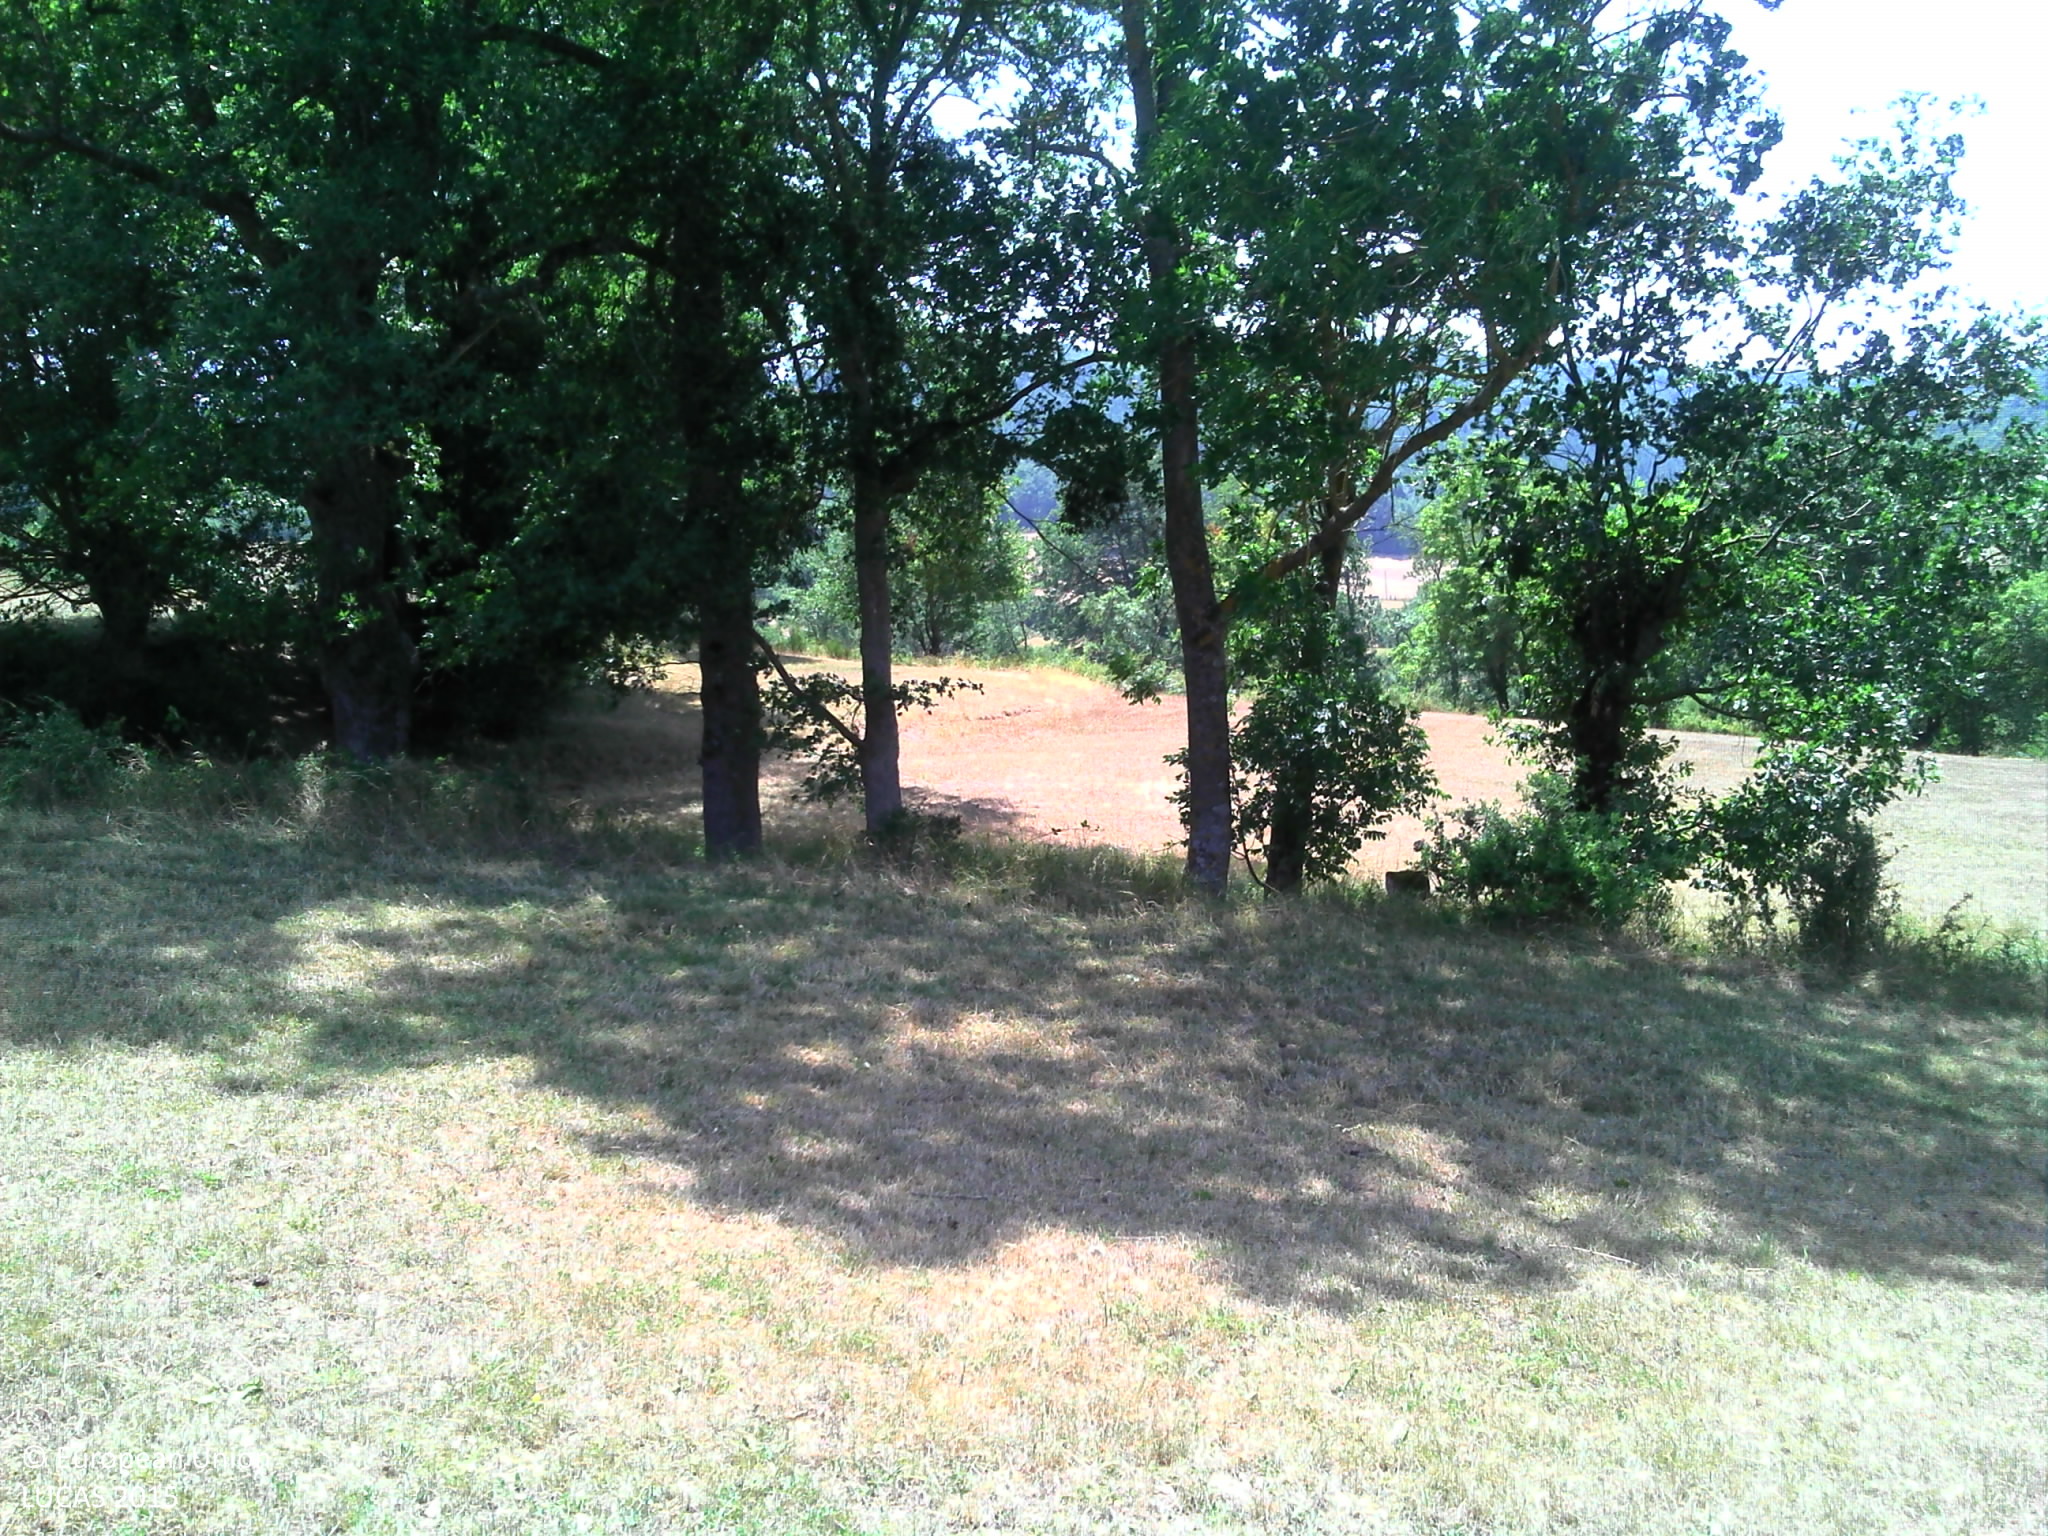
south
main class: Grassland
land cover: Grassland without tree/shrub cover
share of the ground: > 75 %
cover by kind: herbaceous plants 100 %
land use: Agriculture (excluding fallow land and kitchen gardens)
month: July
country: FR
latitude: 45.2104
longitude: 3.1645
